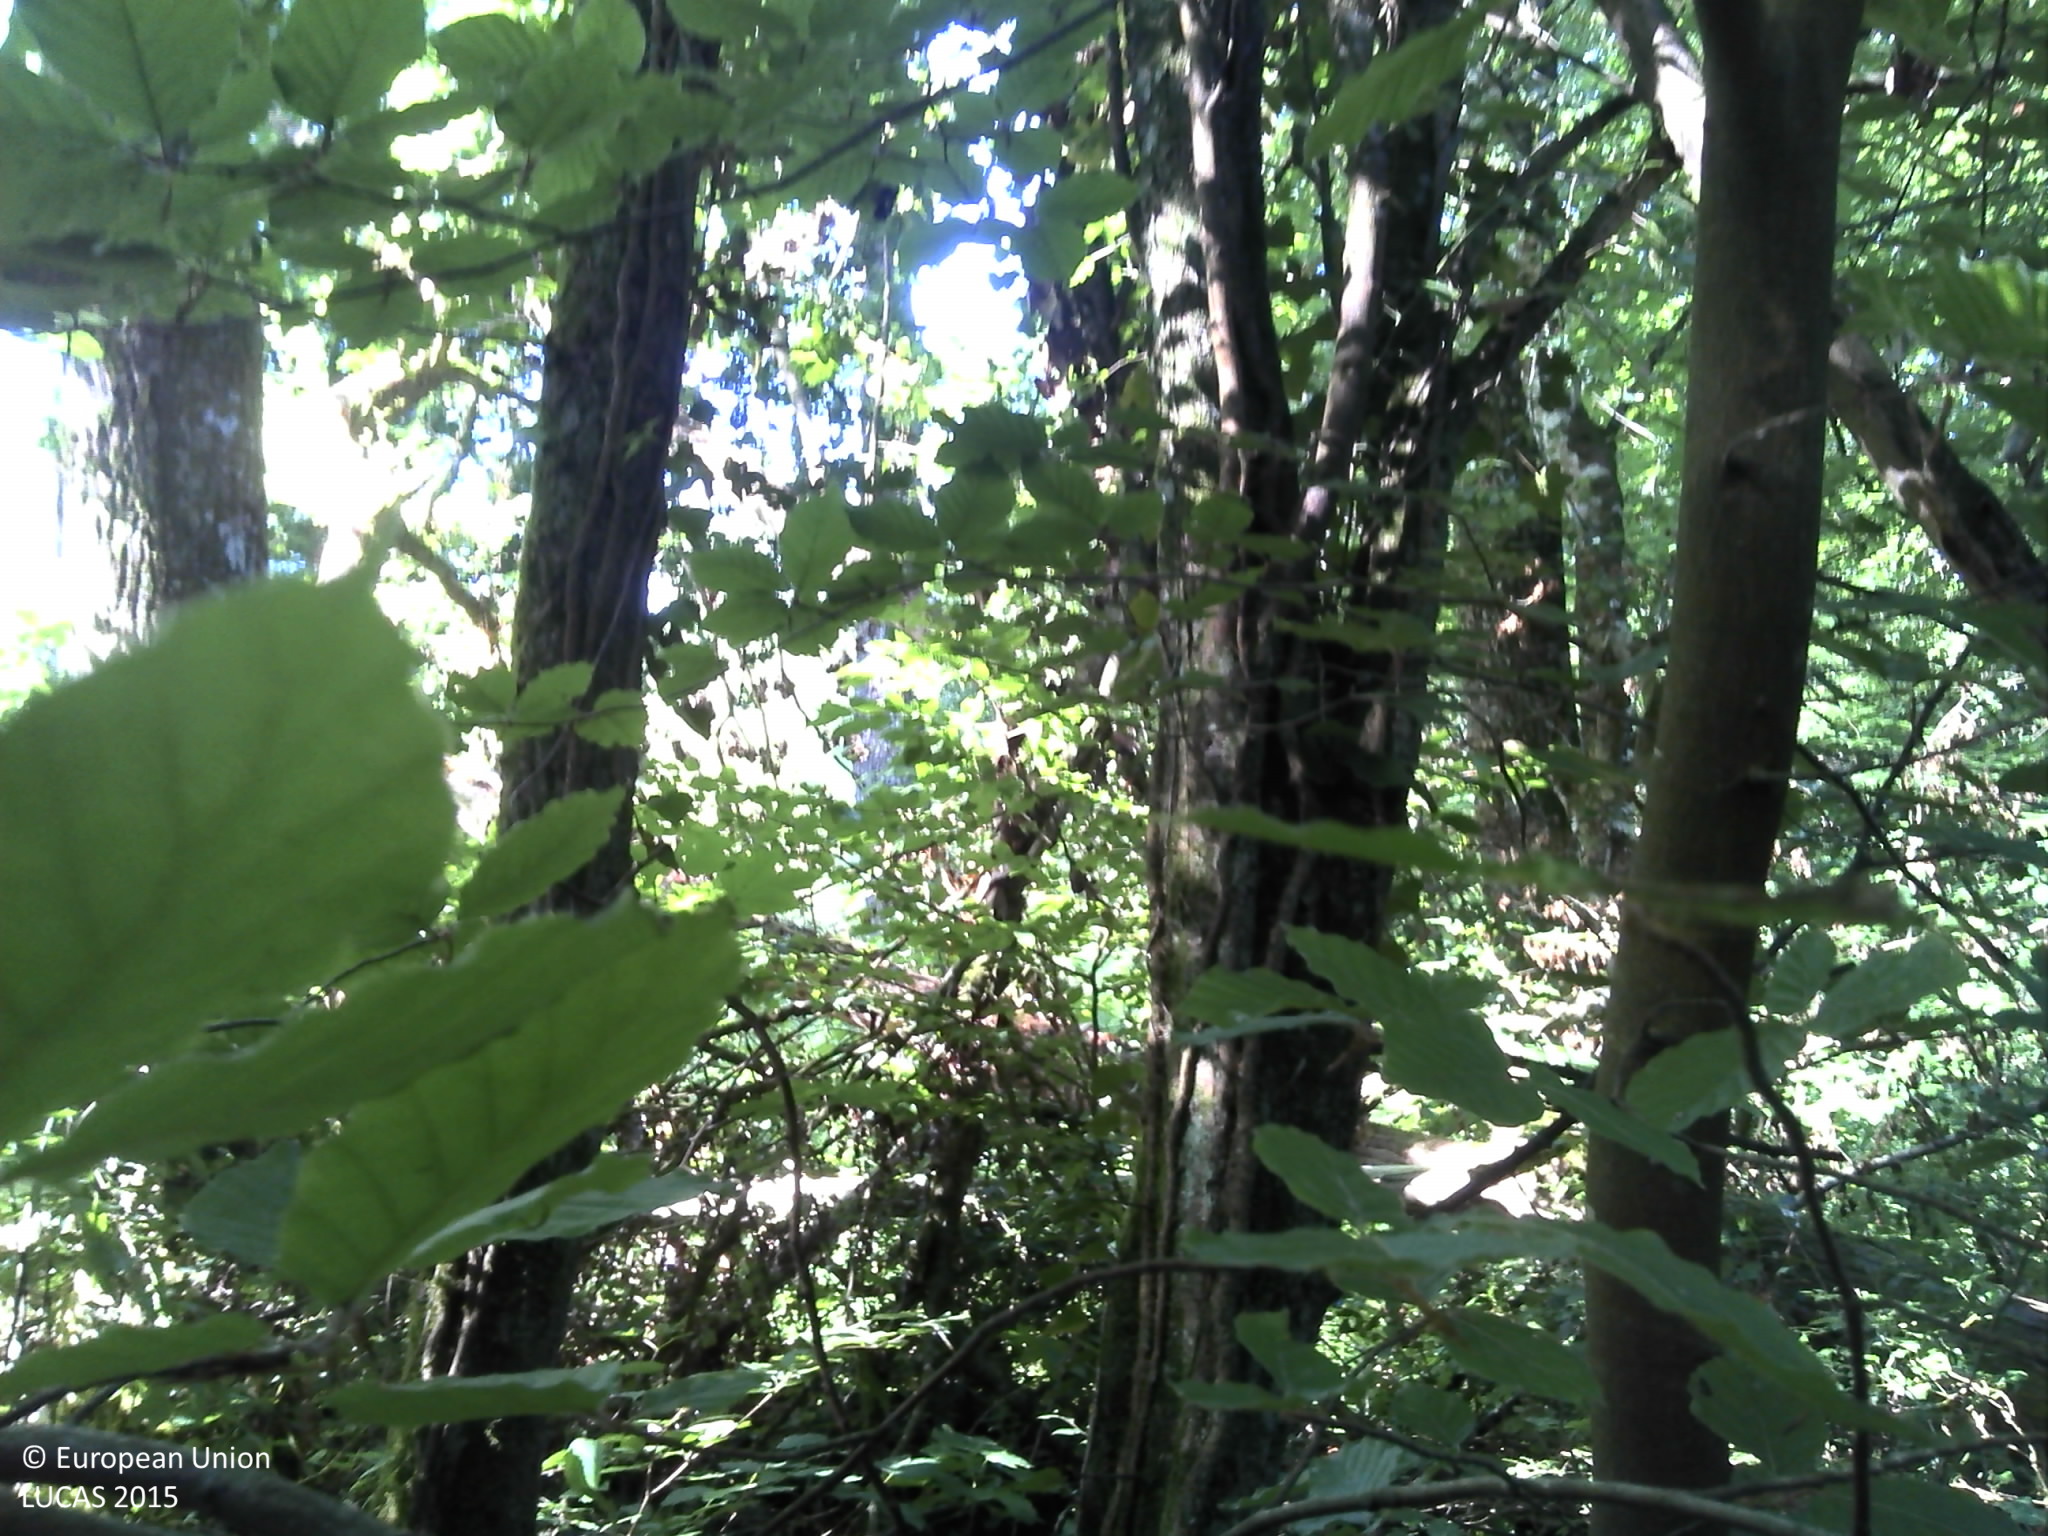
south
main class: Woodland
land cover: Broadleaved woodland
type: beech forest
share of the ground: > 75 %
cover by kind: broadleaved forest trees 70 %, herbaceous plants 20 %, consolidated bare surface 10 %
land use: Forestry
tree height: > 5 m
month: July
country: FR
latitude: 49.6103
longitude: 4.6963
